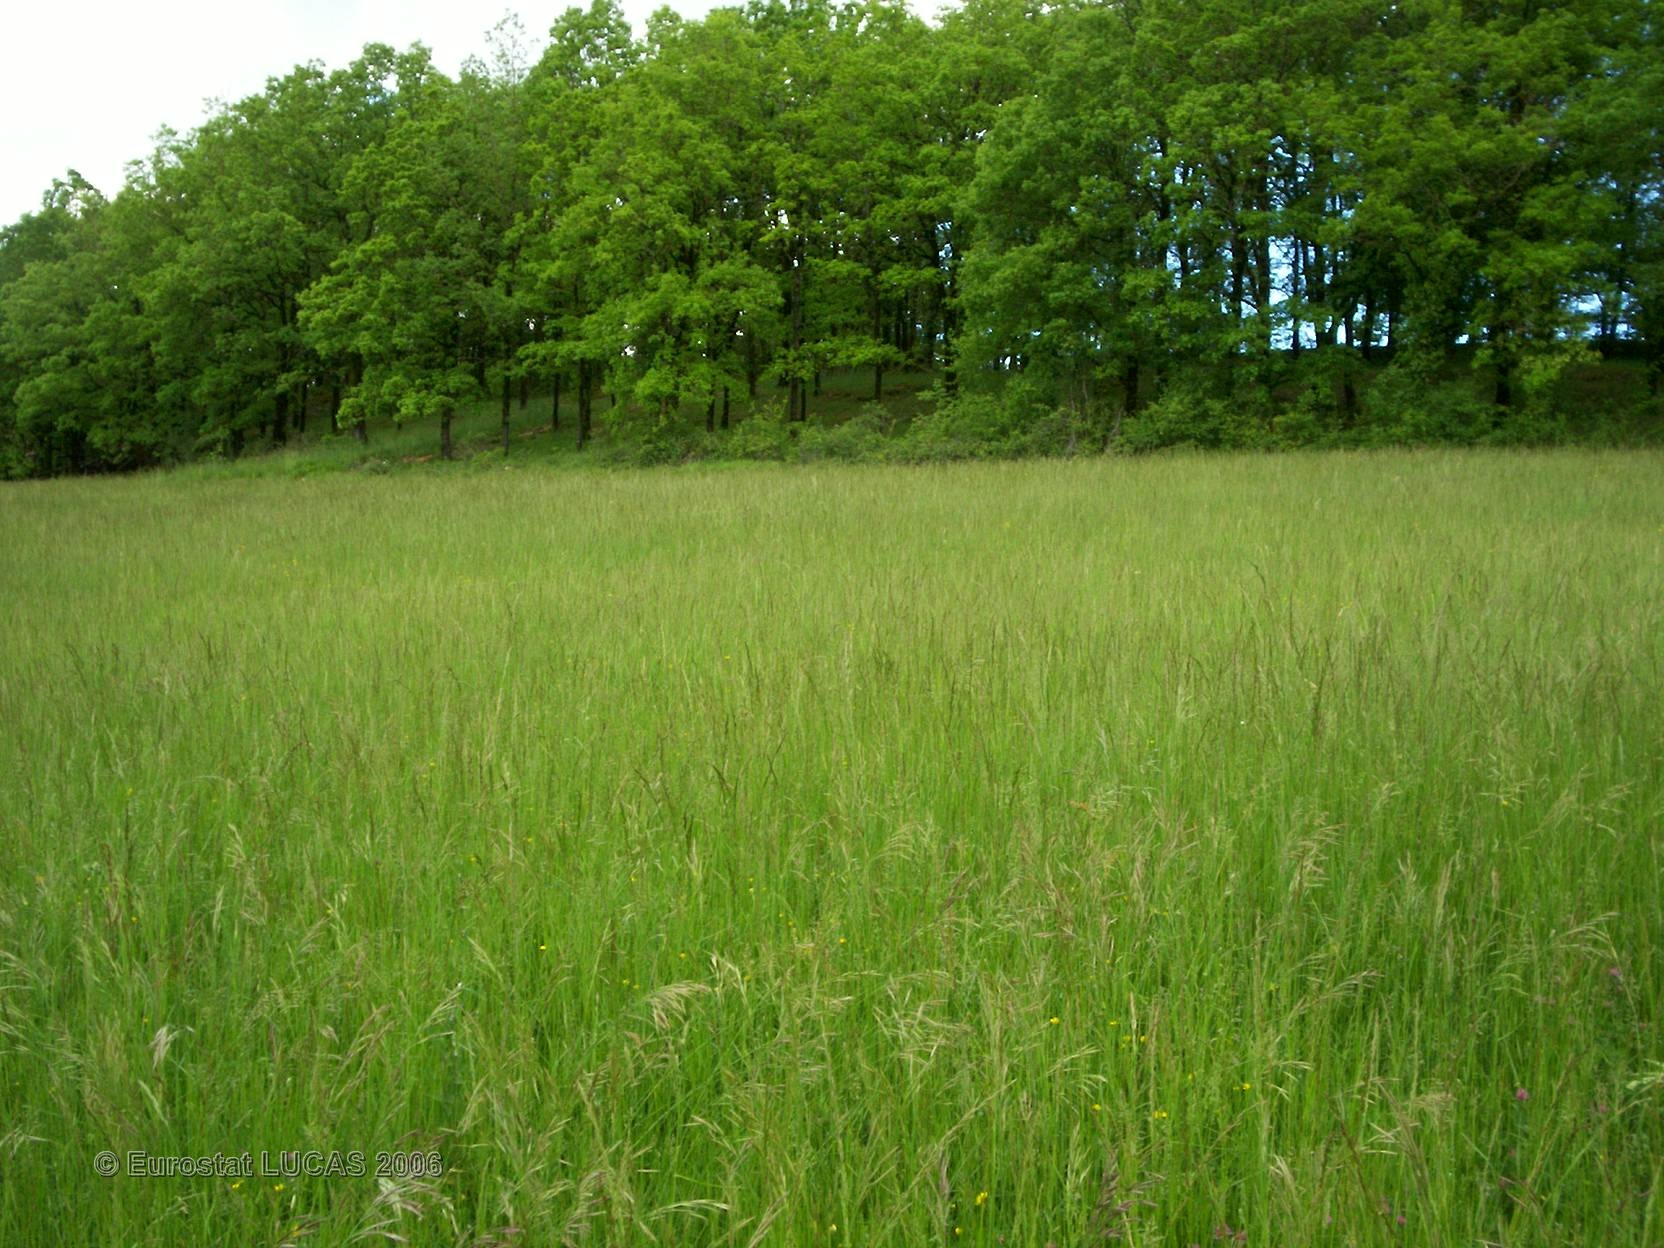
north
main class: Grassland
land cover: Grassland without tree/shrub cover
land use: Agriculture (excluding fallow land and kitchen gardens)
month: May
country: FR
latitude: 45.1096
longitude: 1.3133
